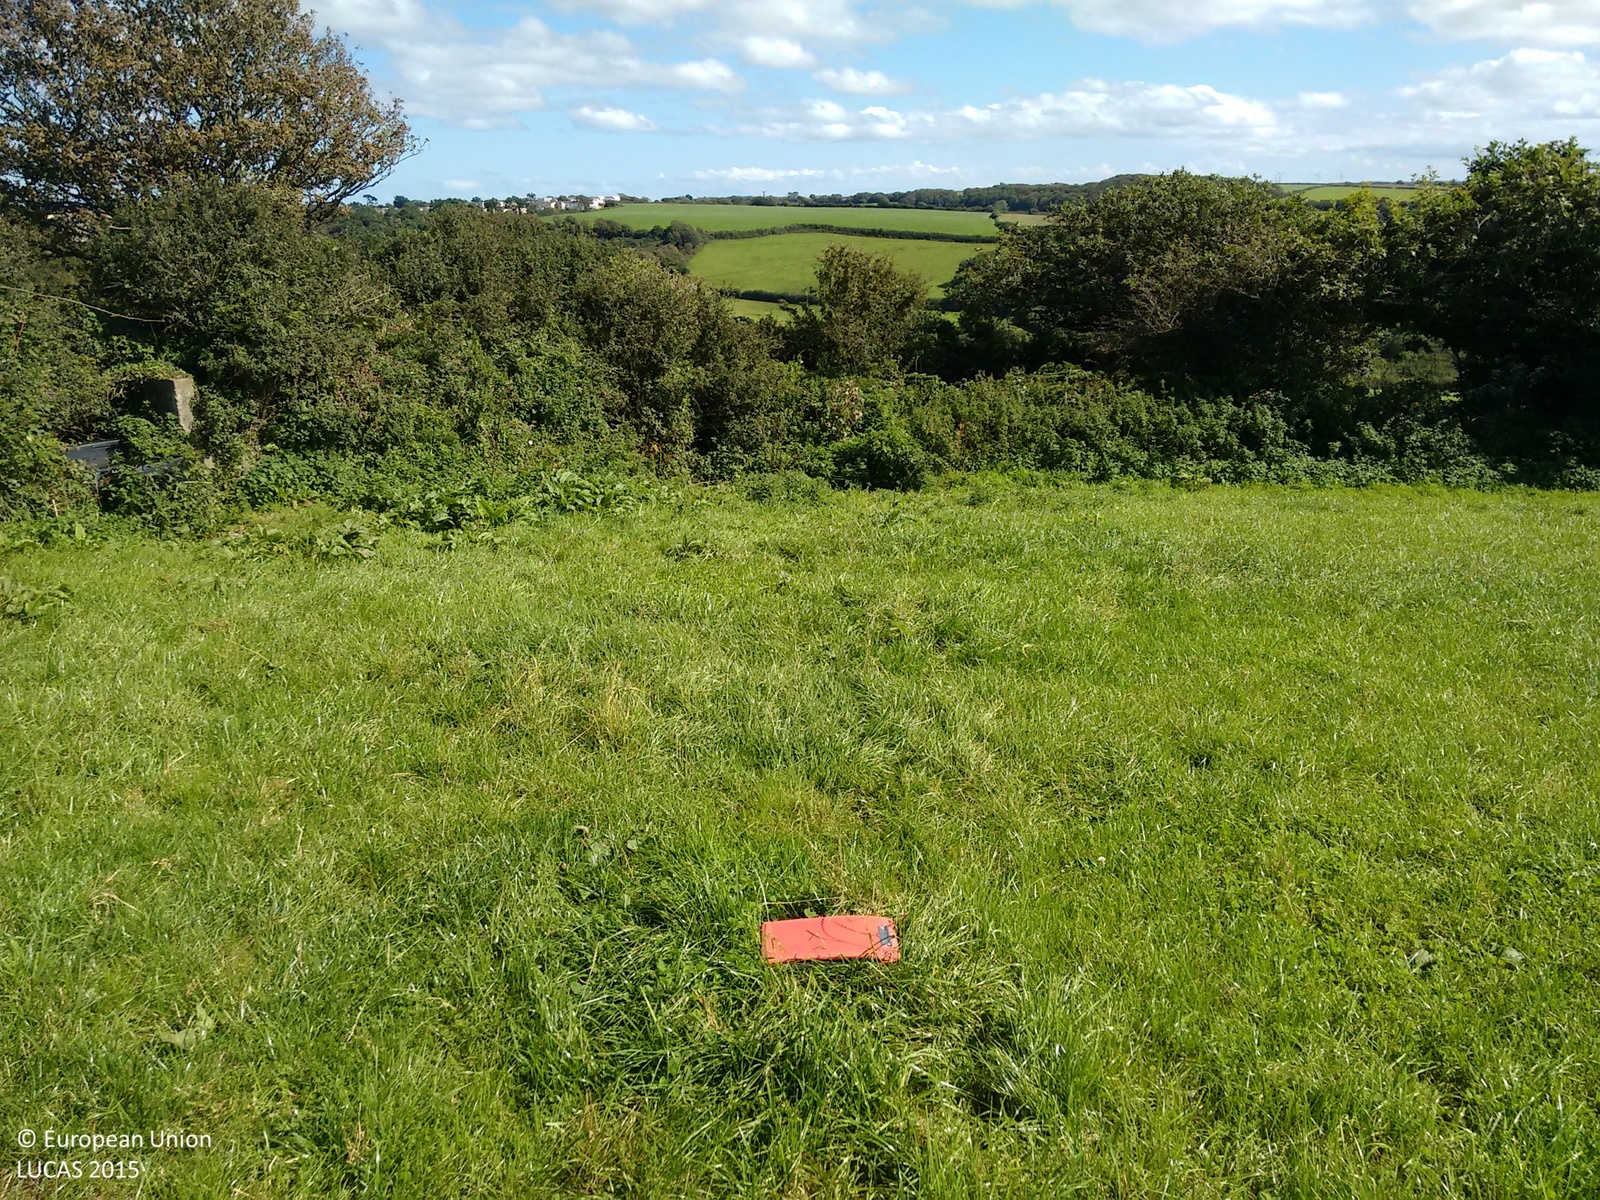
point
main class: Grassland
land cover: Grassland without tree/shrub cover
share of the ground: > 75 %
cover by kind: herbaceous plants 100 %
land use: Agriculture (excluding fallow land and kitchen gardens)
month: September
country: GB
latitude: 50.0968
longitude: -5.2898
